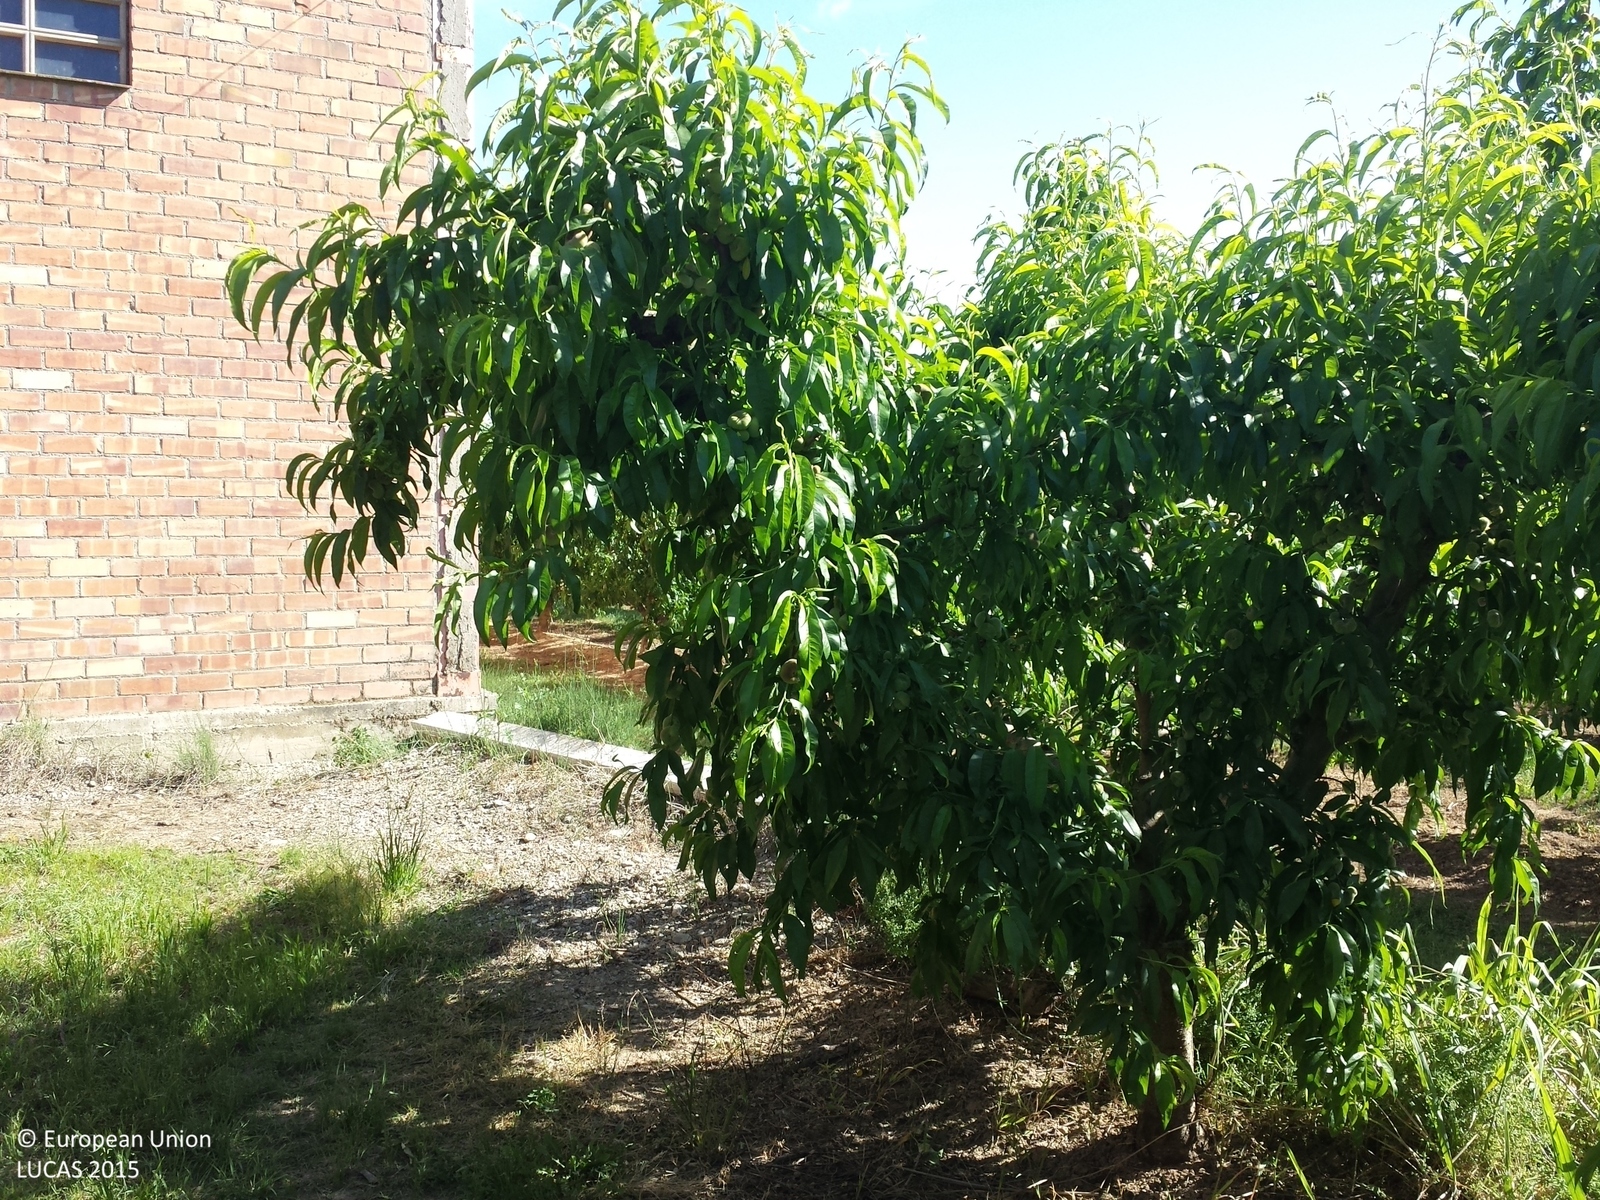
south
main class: Cropland
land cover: Other fruit trees and berries
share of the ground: 25 - 50 %
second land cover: Grassland without tree/shrub cover
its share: 50 - 75 %
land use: Agriculture (excluding fallow land and kitchen gardens)
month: May
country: ES
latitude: 41.6355
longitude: 0.6119
